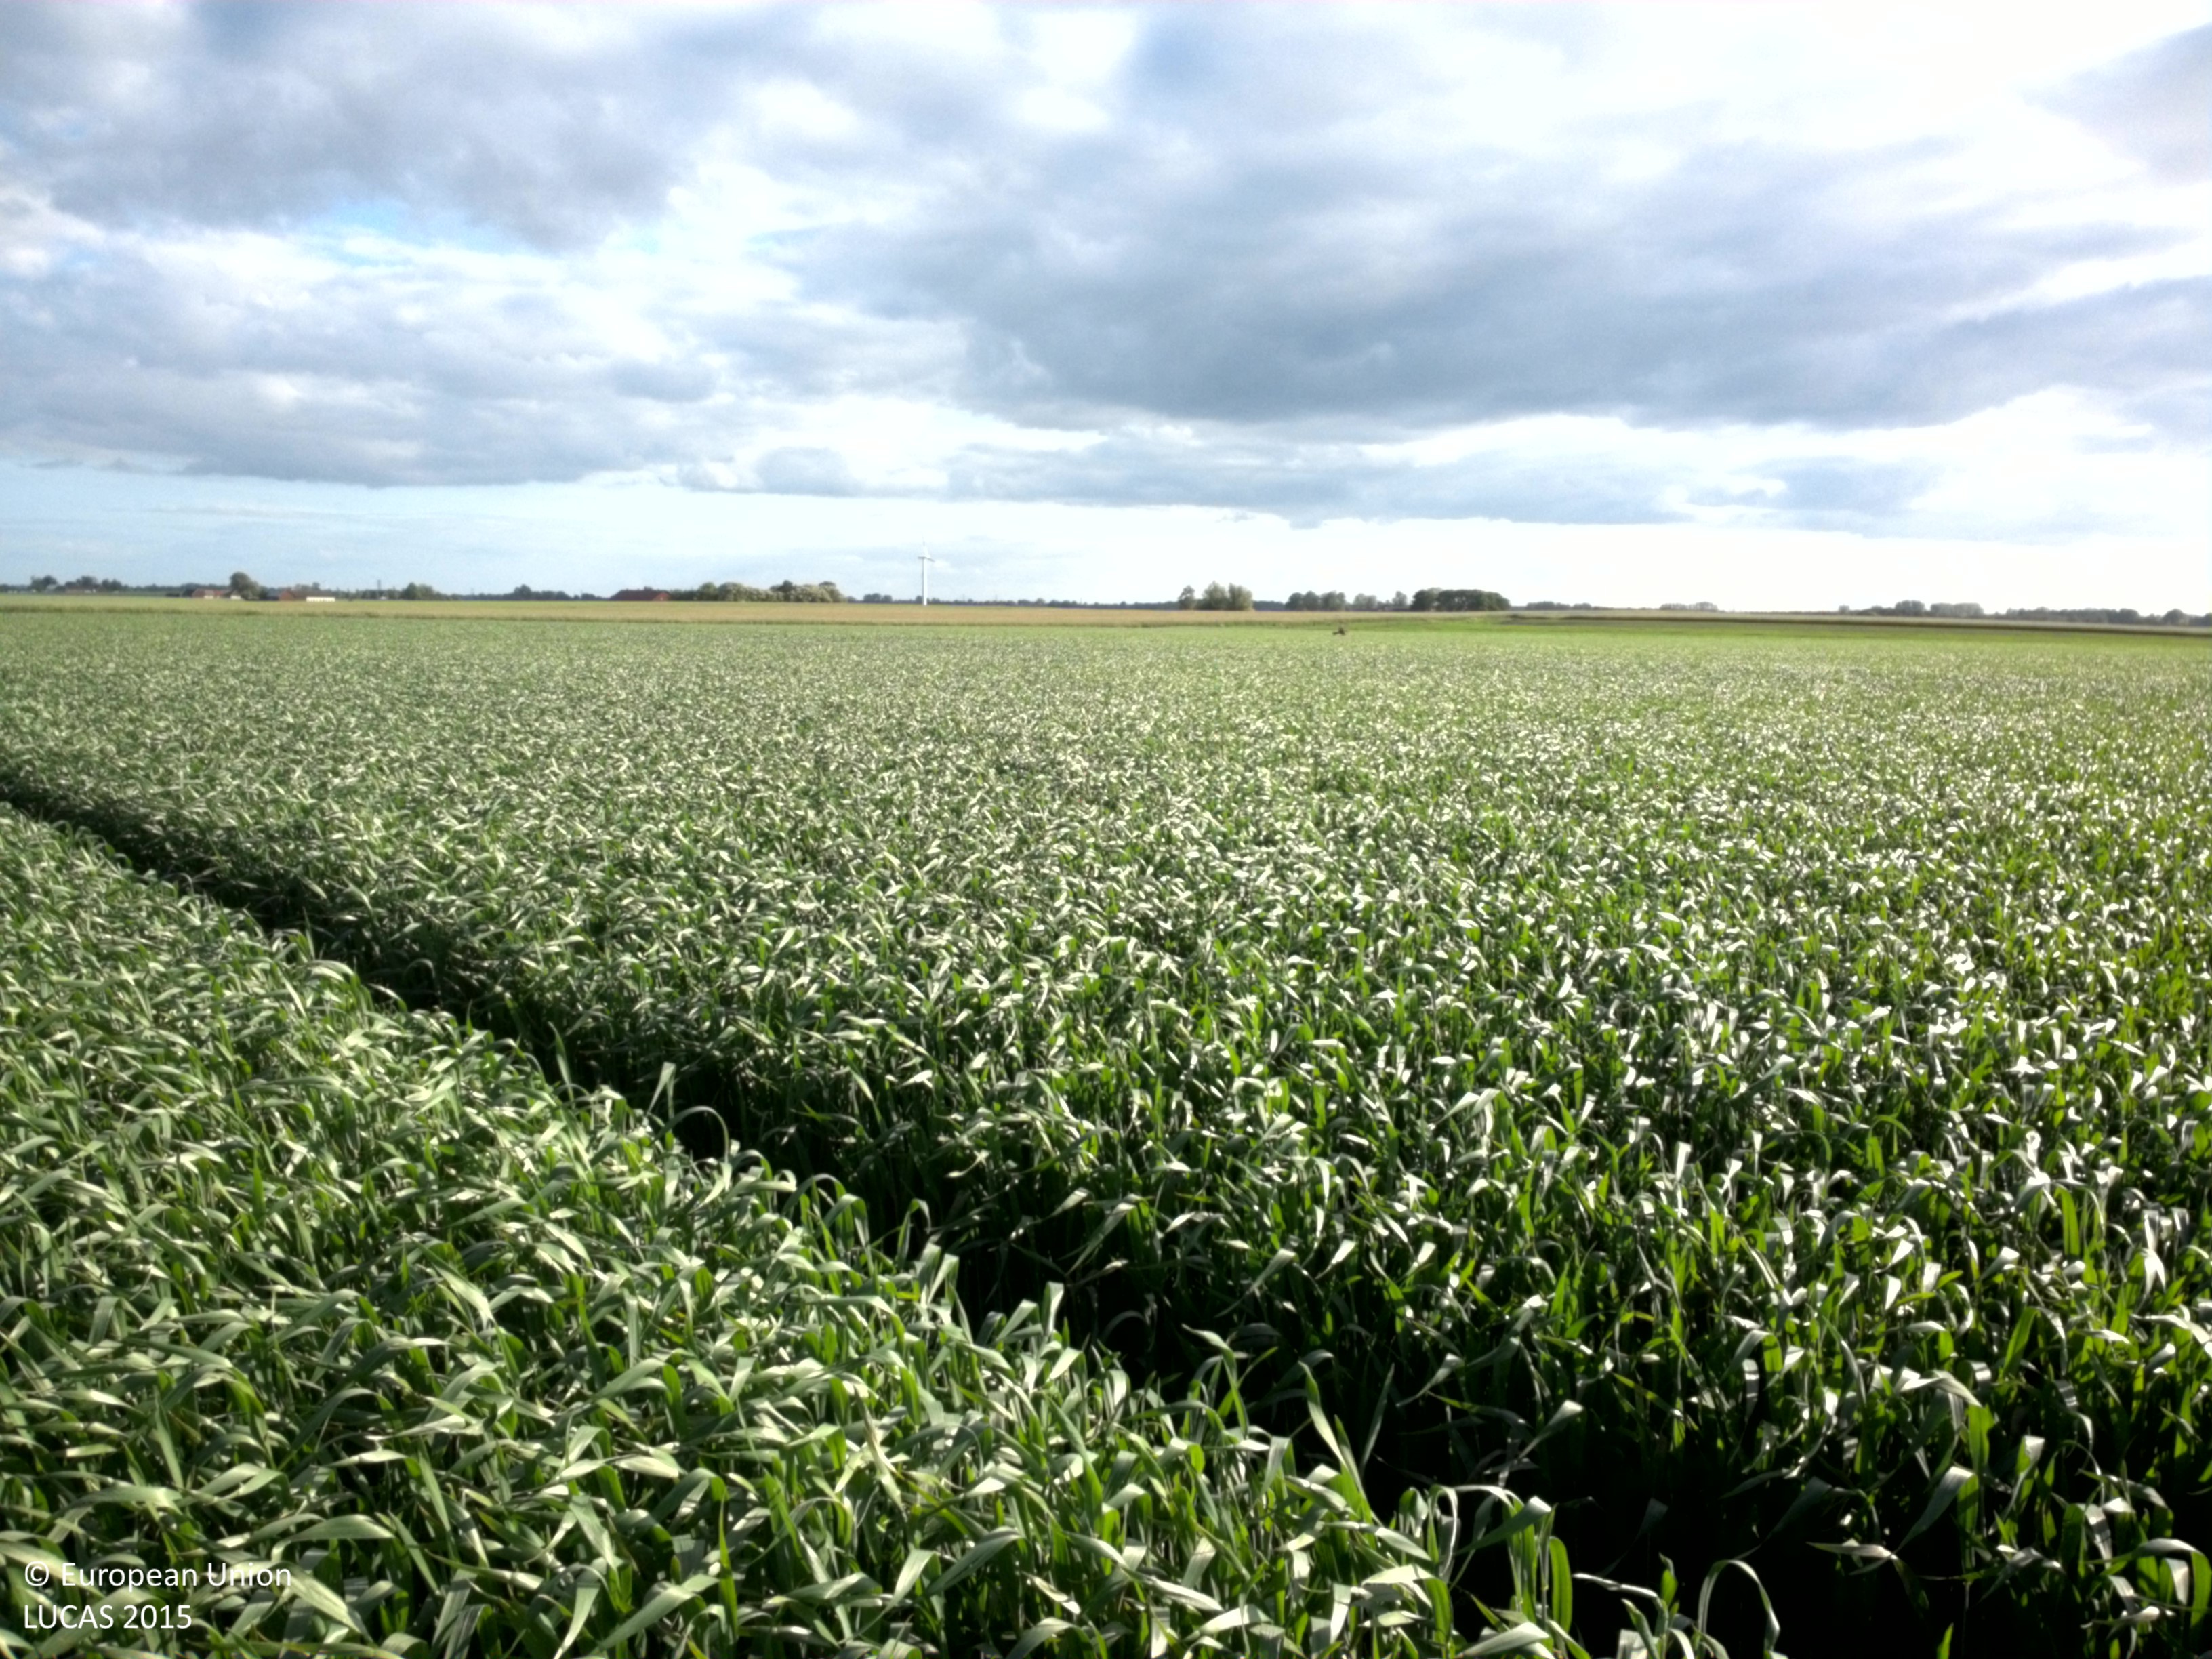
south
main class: Cropland
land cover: Common wheat
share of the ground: > 75 %
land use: Agriculture (excluding fallow land and kitchen gardens)
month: June
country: SE
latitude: 55.7919
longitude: 13.0441
